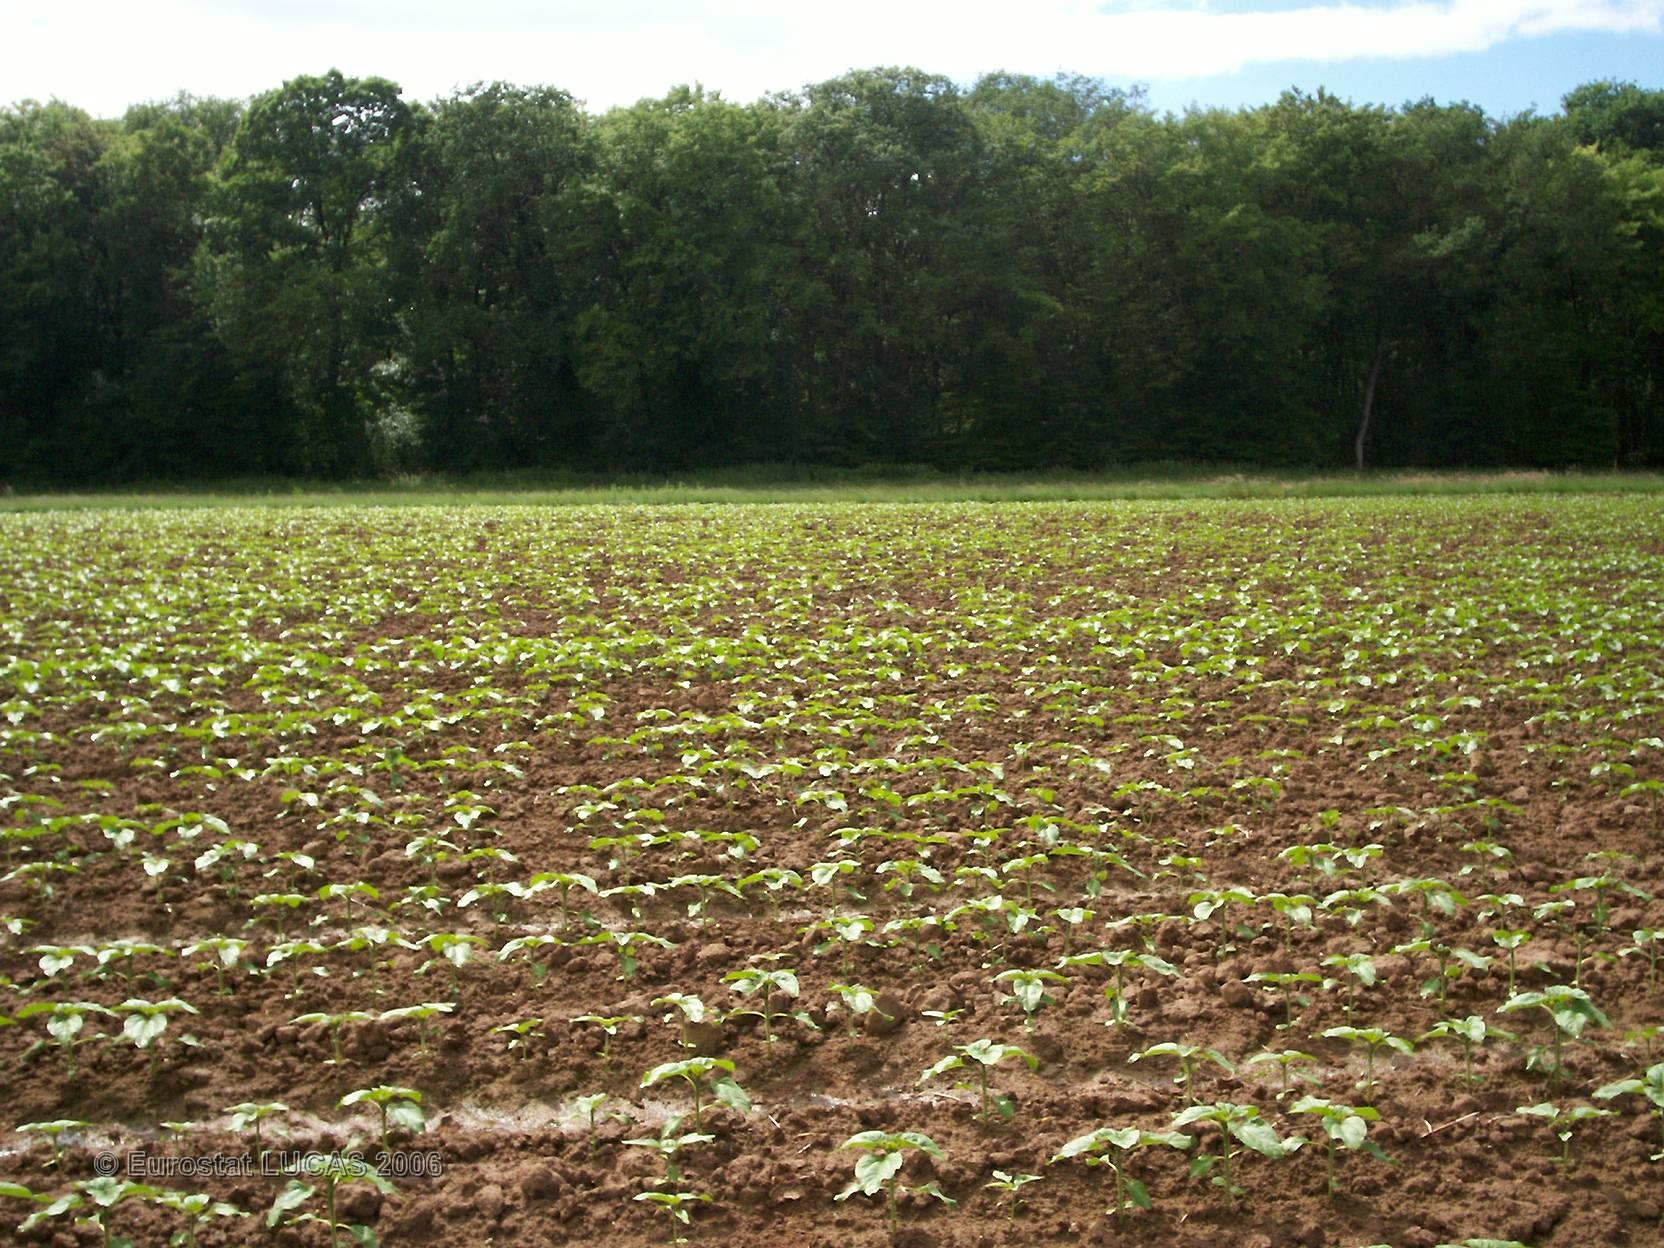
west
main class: Cropland
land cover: Sunflower
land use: Agriculture (excluding fallow land and kitchen gardens)
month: May
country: FR
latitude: 47.1514
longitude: 2.9922
